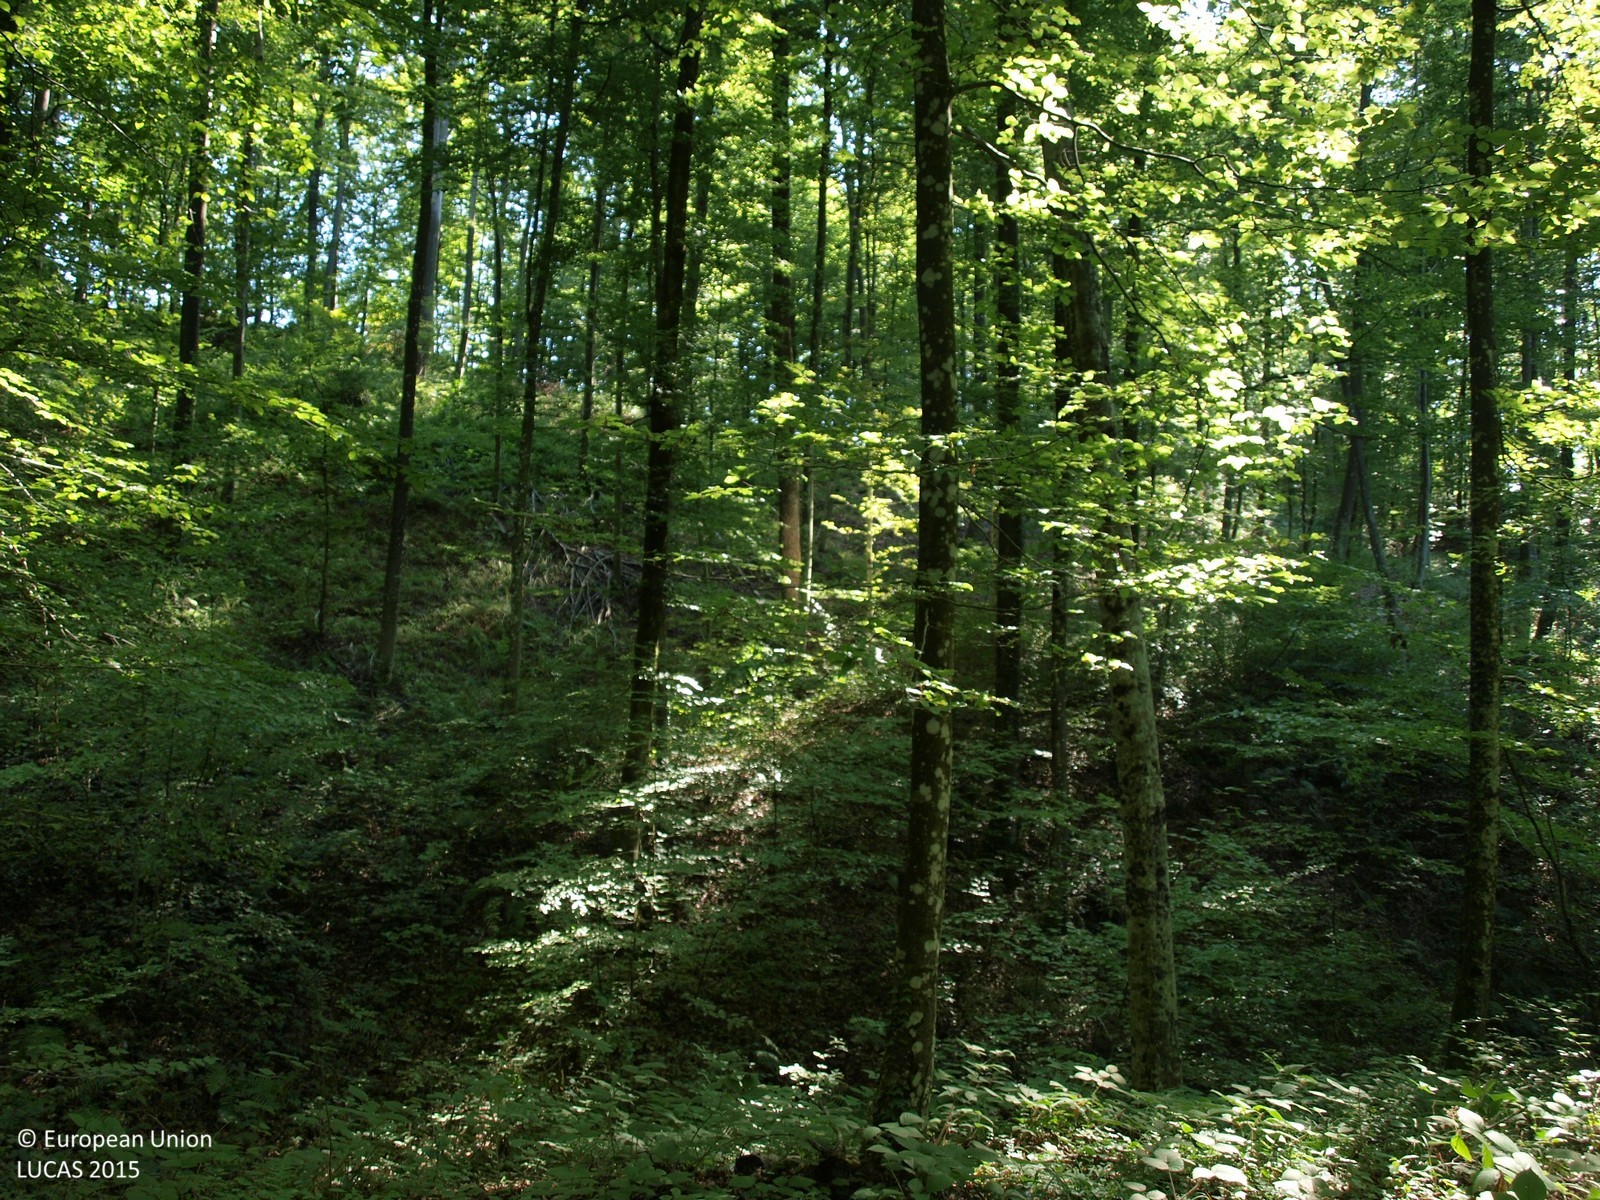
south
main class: Woodland
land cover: Broadleaved woodland
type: mesophytic deciduous forest
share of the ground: > 75 %
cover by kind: broadleaved forest trees 100 %
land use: Forestry
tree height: > 5 m
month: September
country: HR
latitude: 45.5488
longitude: 16.0301
